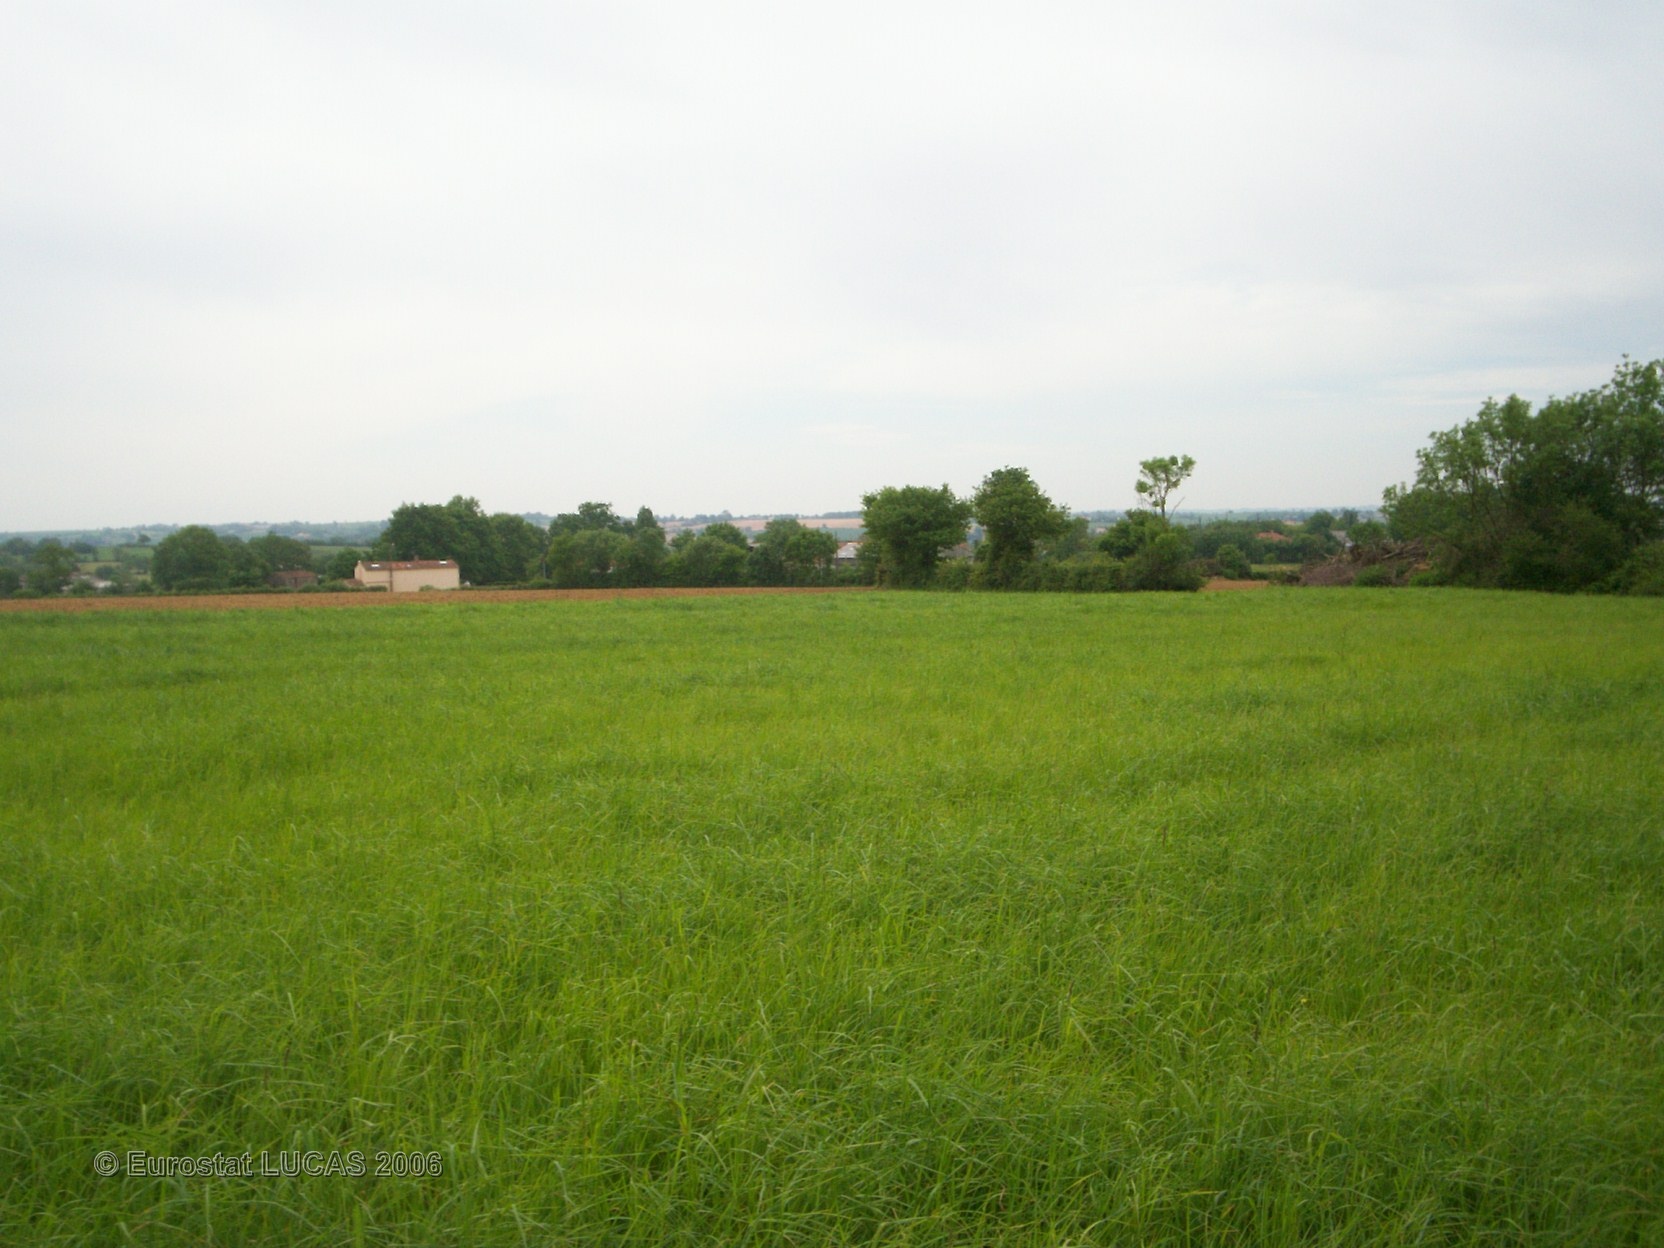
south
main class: Grassland
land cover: Grassland without tree/shrub cover
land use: Agriculture (excluding fallow land and kitchen gardens)
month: May
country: FR
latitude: 46.7212
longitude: -0.8777
